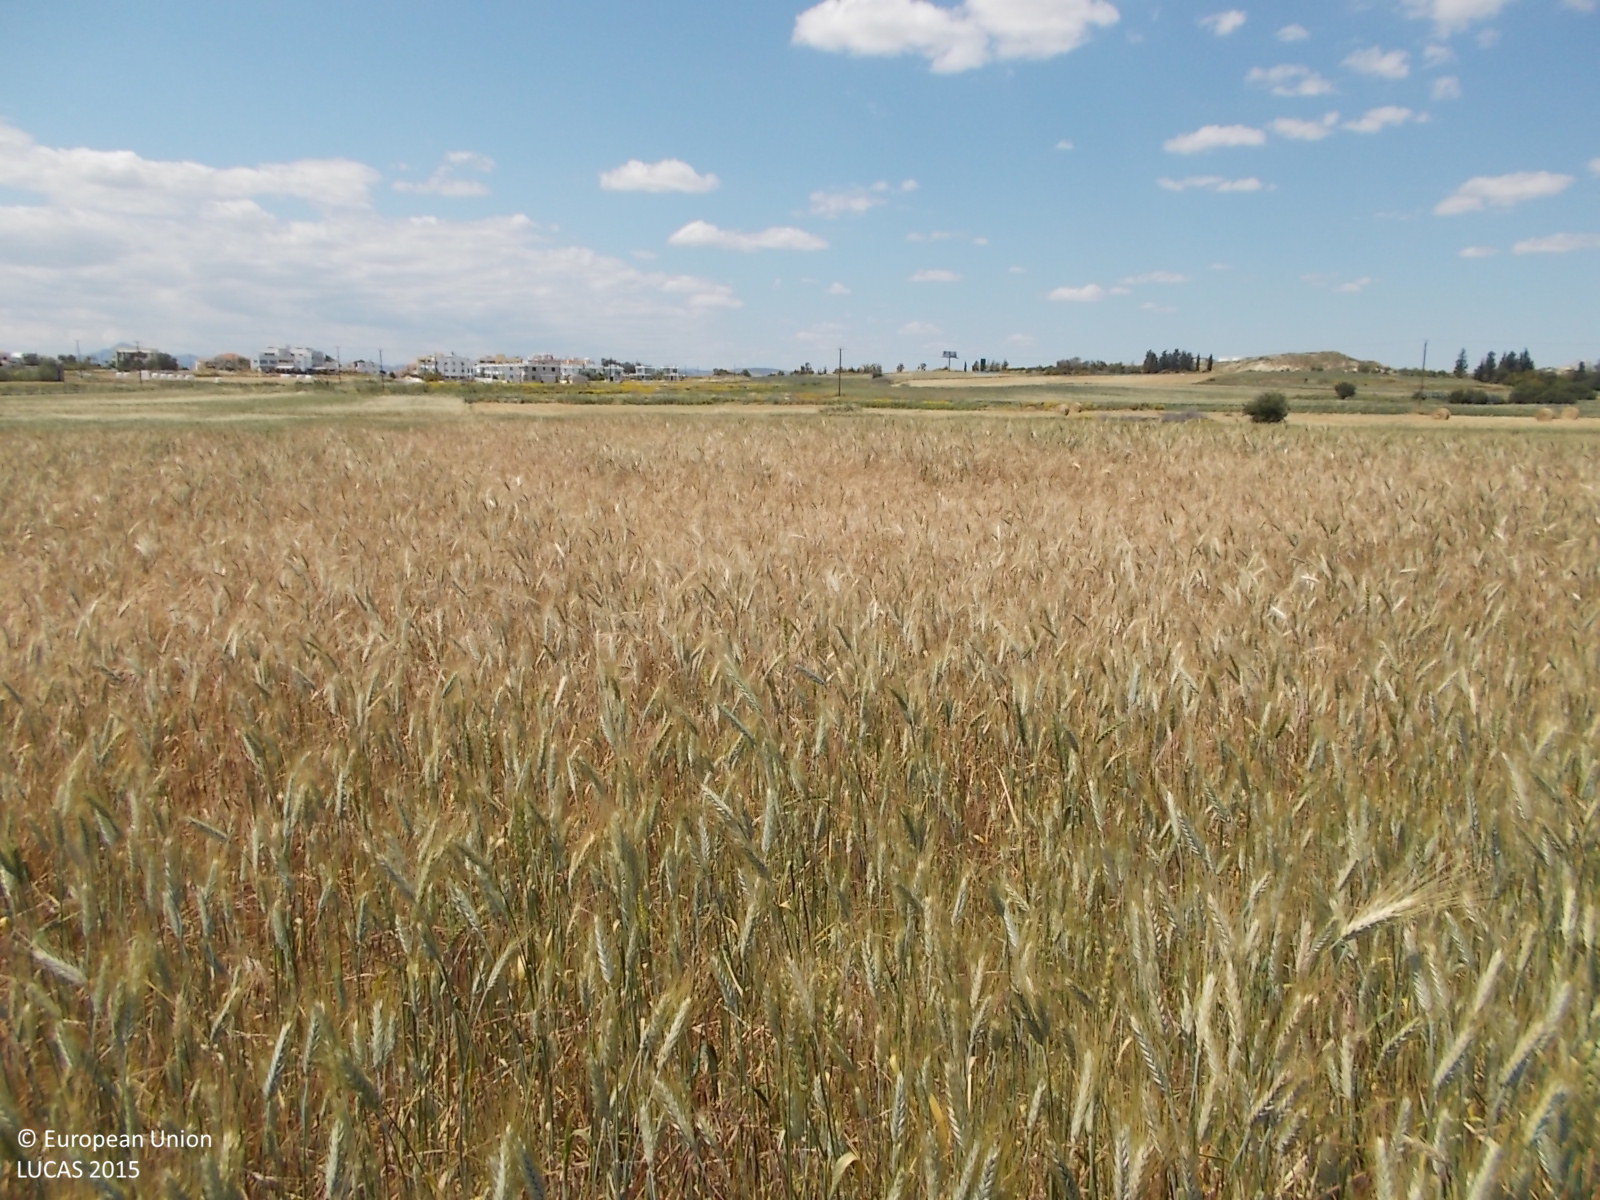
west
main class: Cropland
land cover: Common wheat
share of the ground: > 75 %
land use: Agriculture (excluding fallow land and kitchen gardens)
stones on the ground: < 10 %
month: April
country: CY
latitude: 34.9641
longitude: 33.6470
